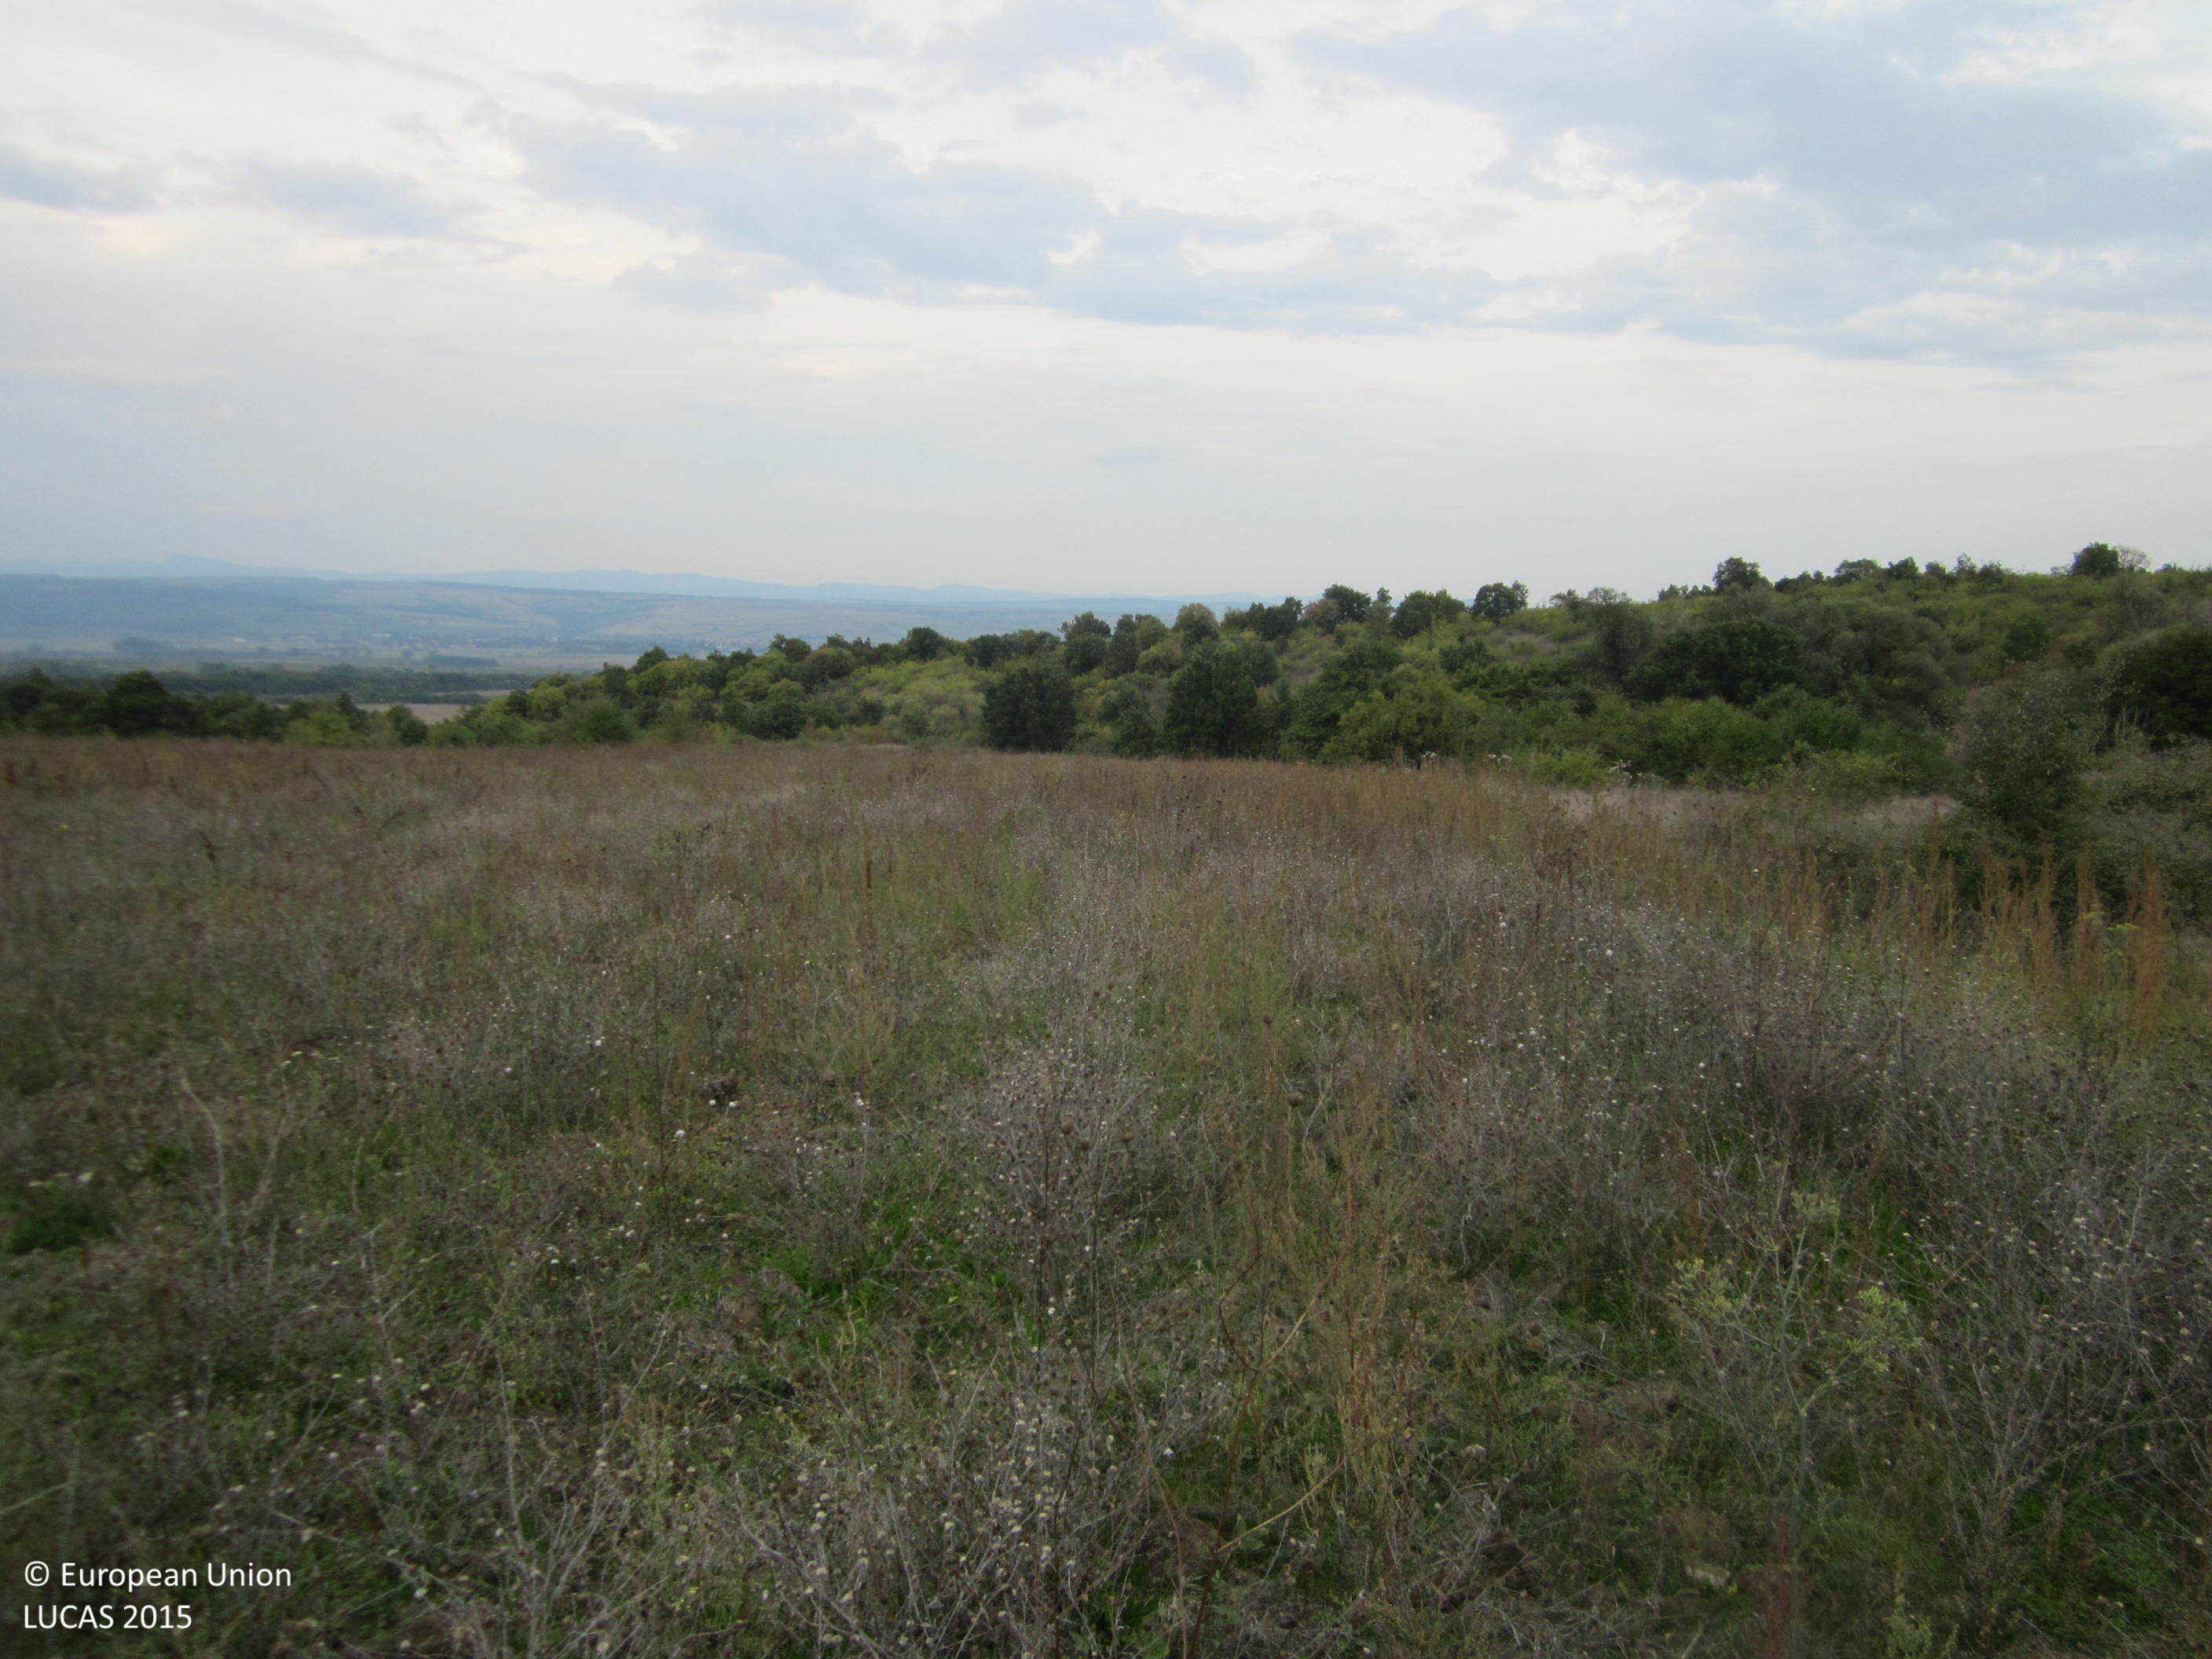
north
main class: Grassland
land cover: Grassland without tree/shrub cover
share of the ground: > 75 %
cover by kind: herbaceous plants 100 %
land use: Agriculture (excluding fallow land and kitchen gardens)
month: October
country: BG
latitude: 42.7124
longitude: 26.7932
